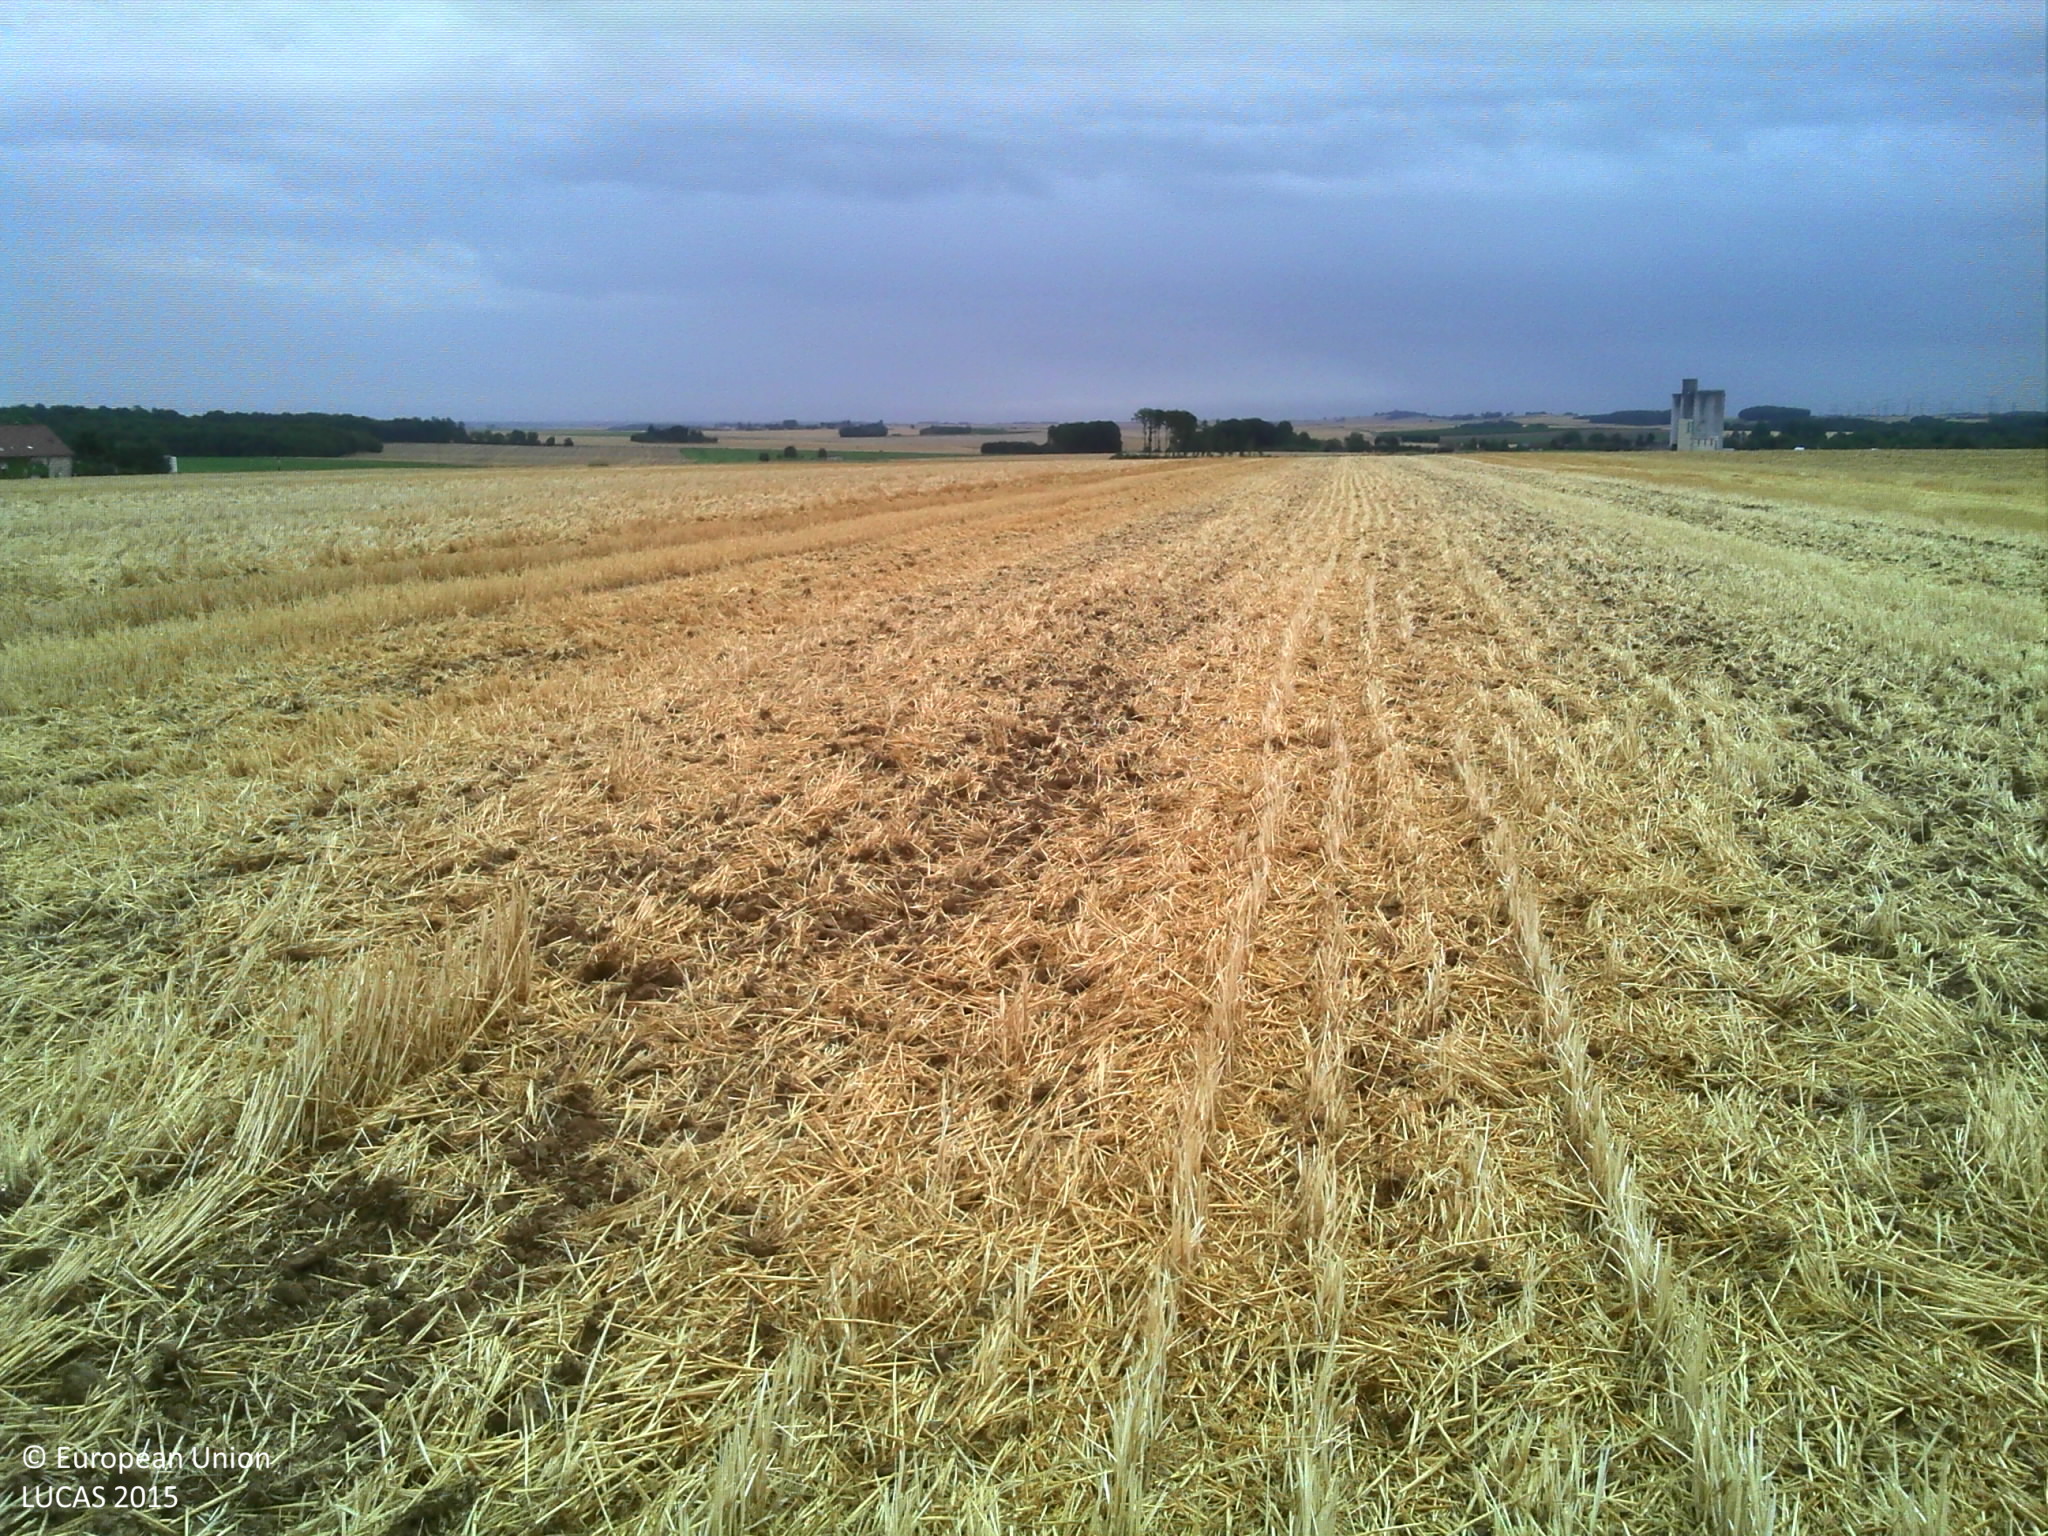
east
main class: Cropland
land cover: Common wheat
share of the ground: > 75 %
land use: Agriculture (excluding fallow land and kitchen gardens)
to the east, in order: Common wheat
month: August
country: FR
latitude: 48.5832
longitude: 3.3645
